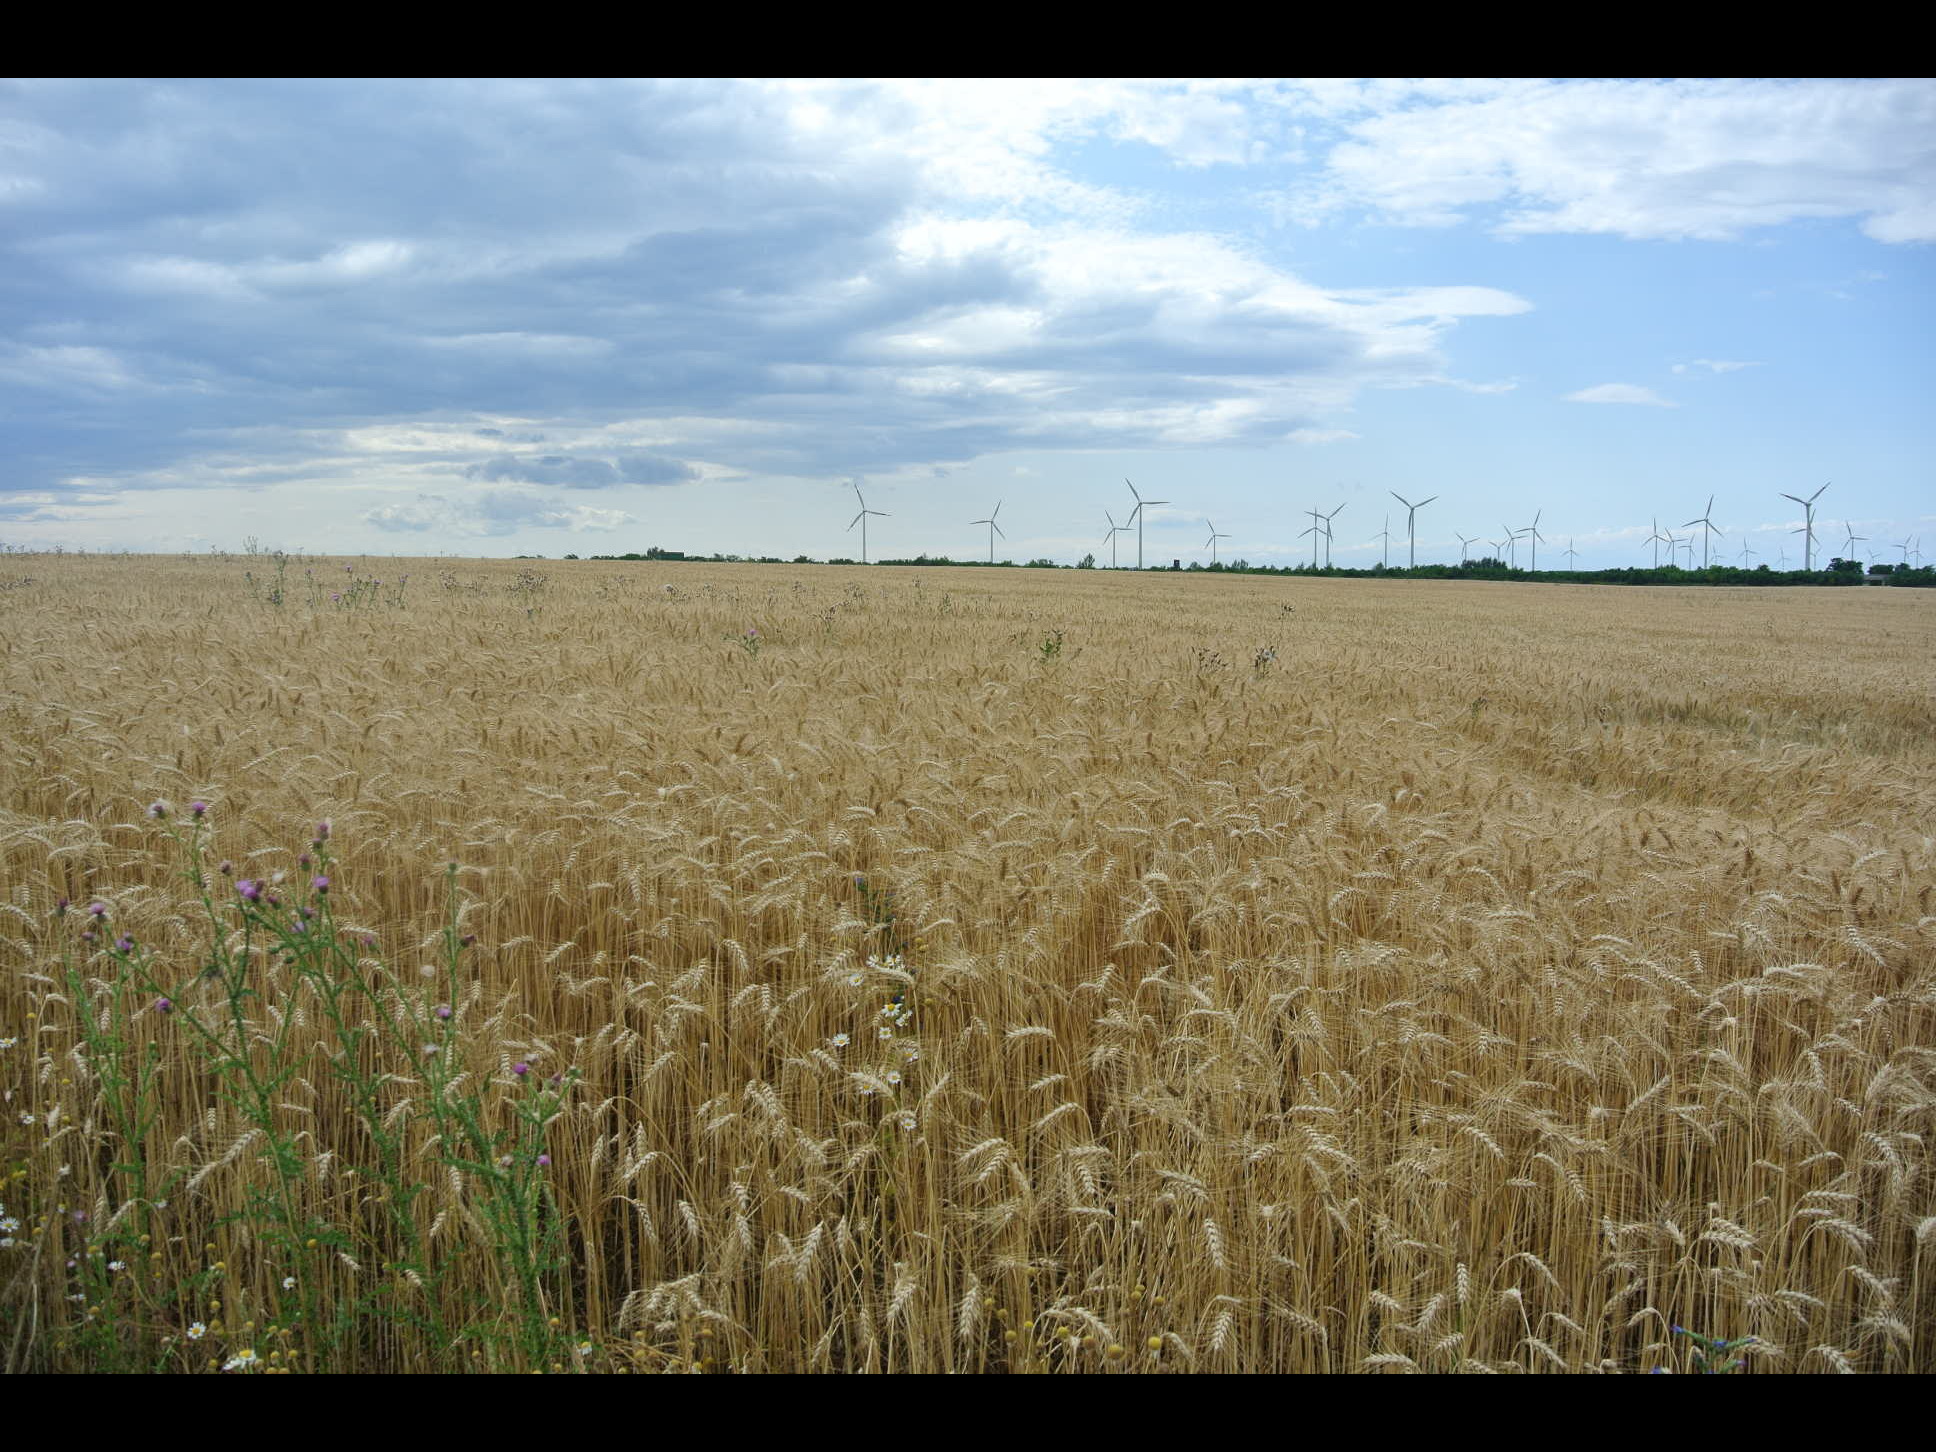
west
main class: Cropland
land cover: Common wheat
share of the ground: > 75 %
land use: Agriculture (excluding fallow land and kitchen gardens)
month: July
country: AT
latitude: 47.9333
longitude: 16.9268
